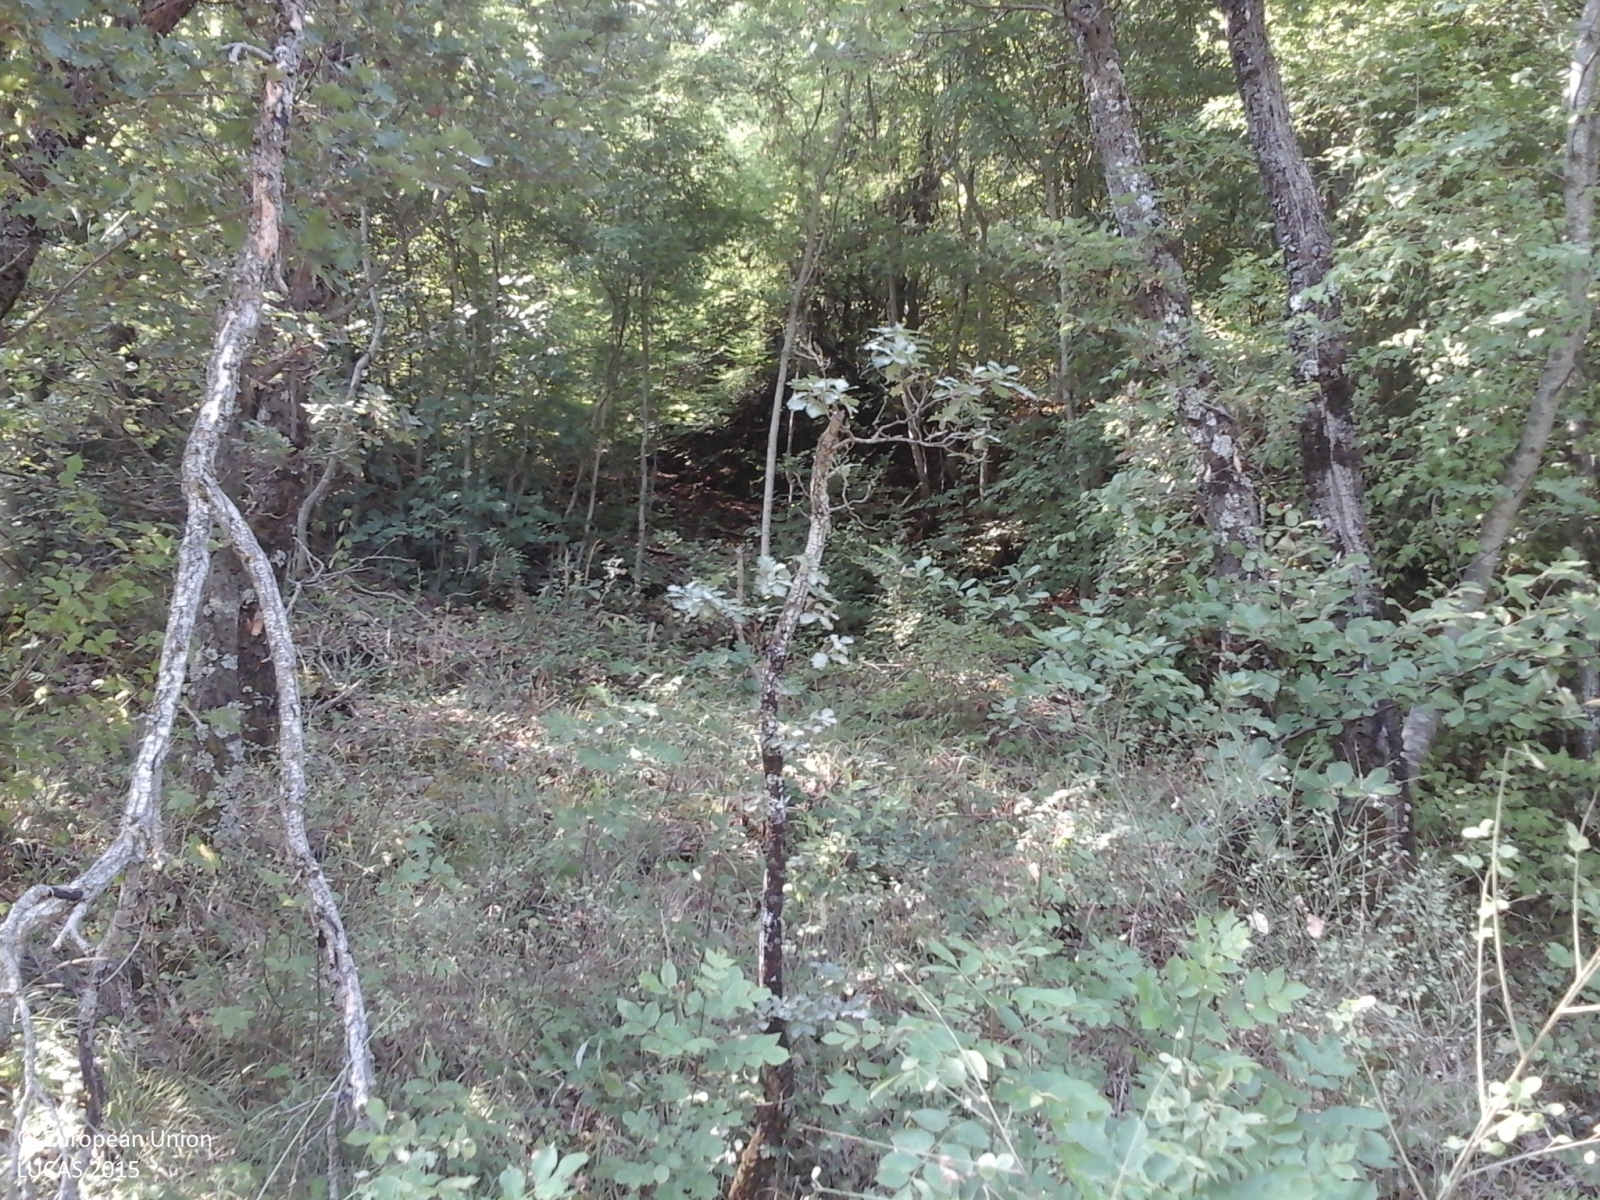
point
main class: Woodland
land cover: Broadleaved woodland
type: thermophilous deciduous forest
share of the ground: > 75 %
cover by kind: broadleaved forest trees 90 %, shrubs 5 %, herbaceous plants 5 %
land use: Semi-natural and natural areas not in use
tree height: > 5 m
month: August
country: IT
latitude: 41.5140
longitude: 14.2860
